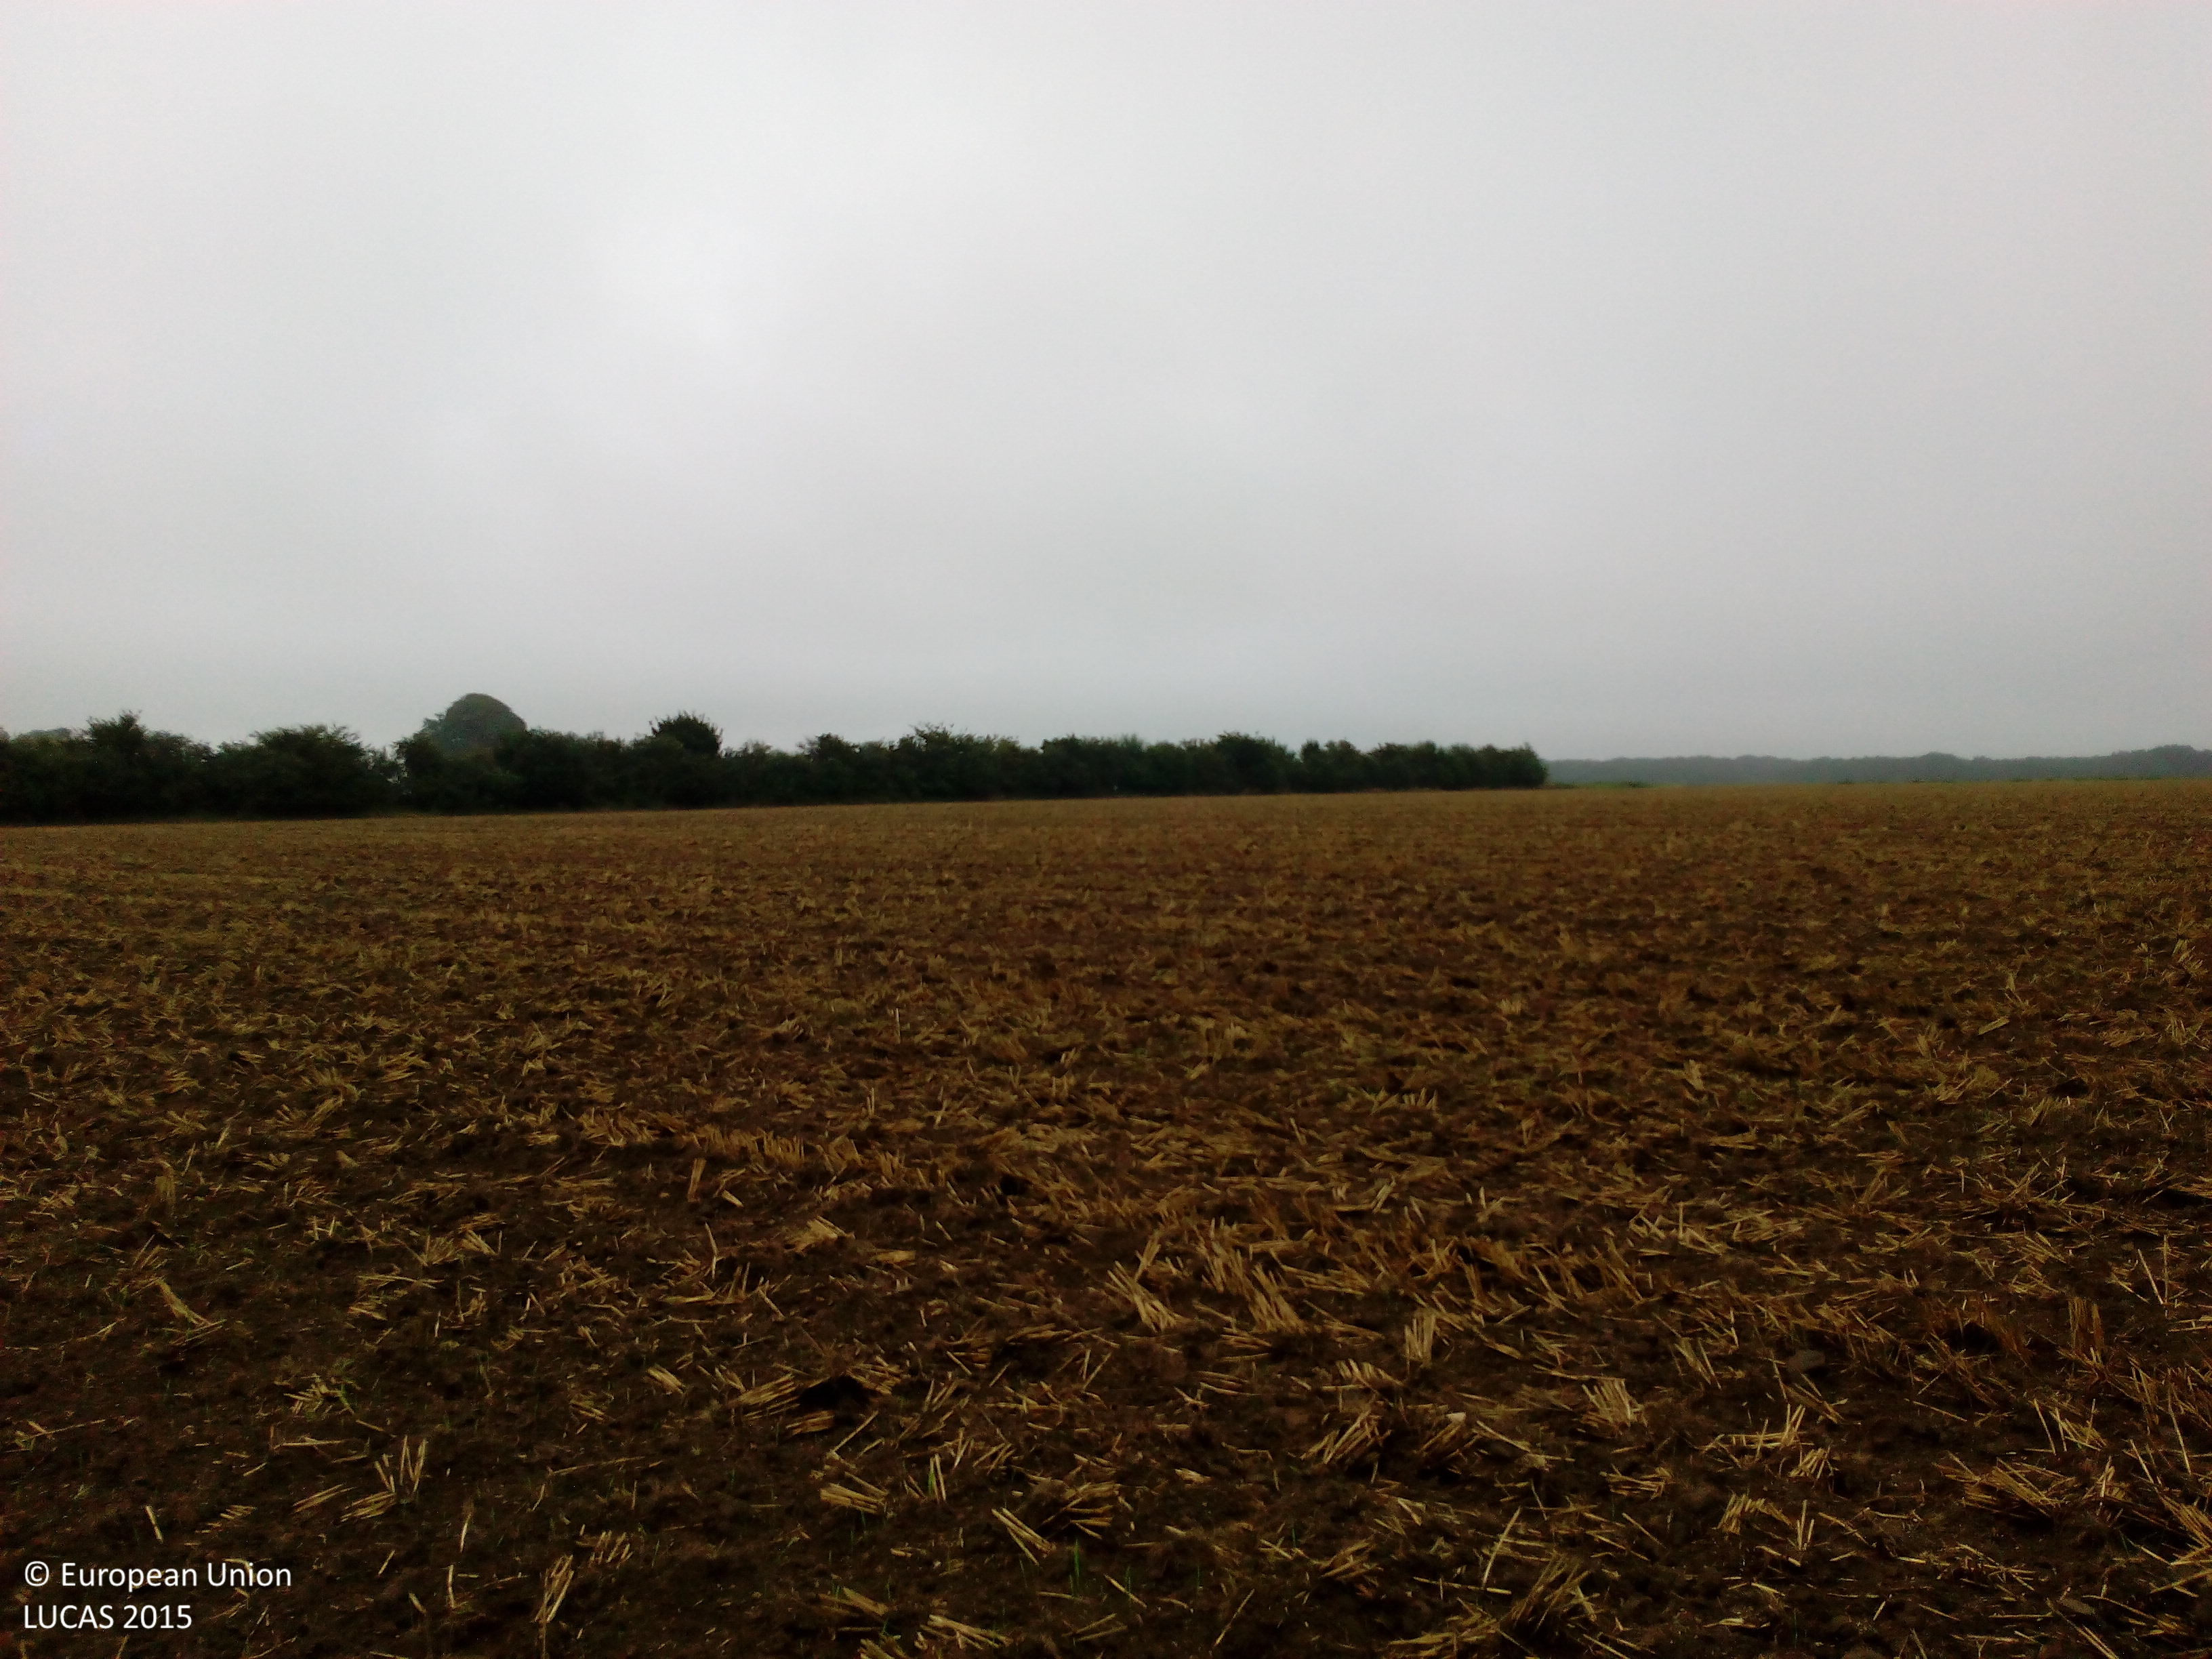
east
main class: Cropland
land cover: Common wheat
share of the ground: < 10 %
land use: Agriculture (excluding fallow land and kitchen gardens)
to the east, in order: Common wheat; Shrubland with sparse tree cover; Tracks; Grass margins; Common wheat
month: August
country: DE
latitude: 52.7998
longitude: 8.5321
